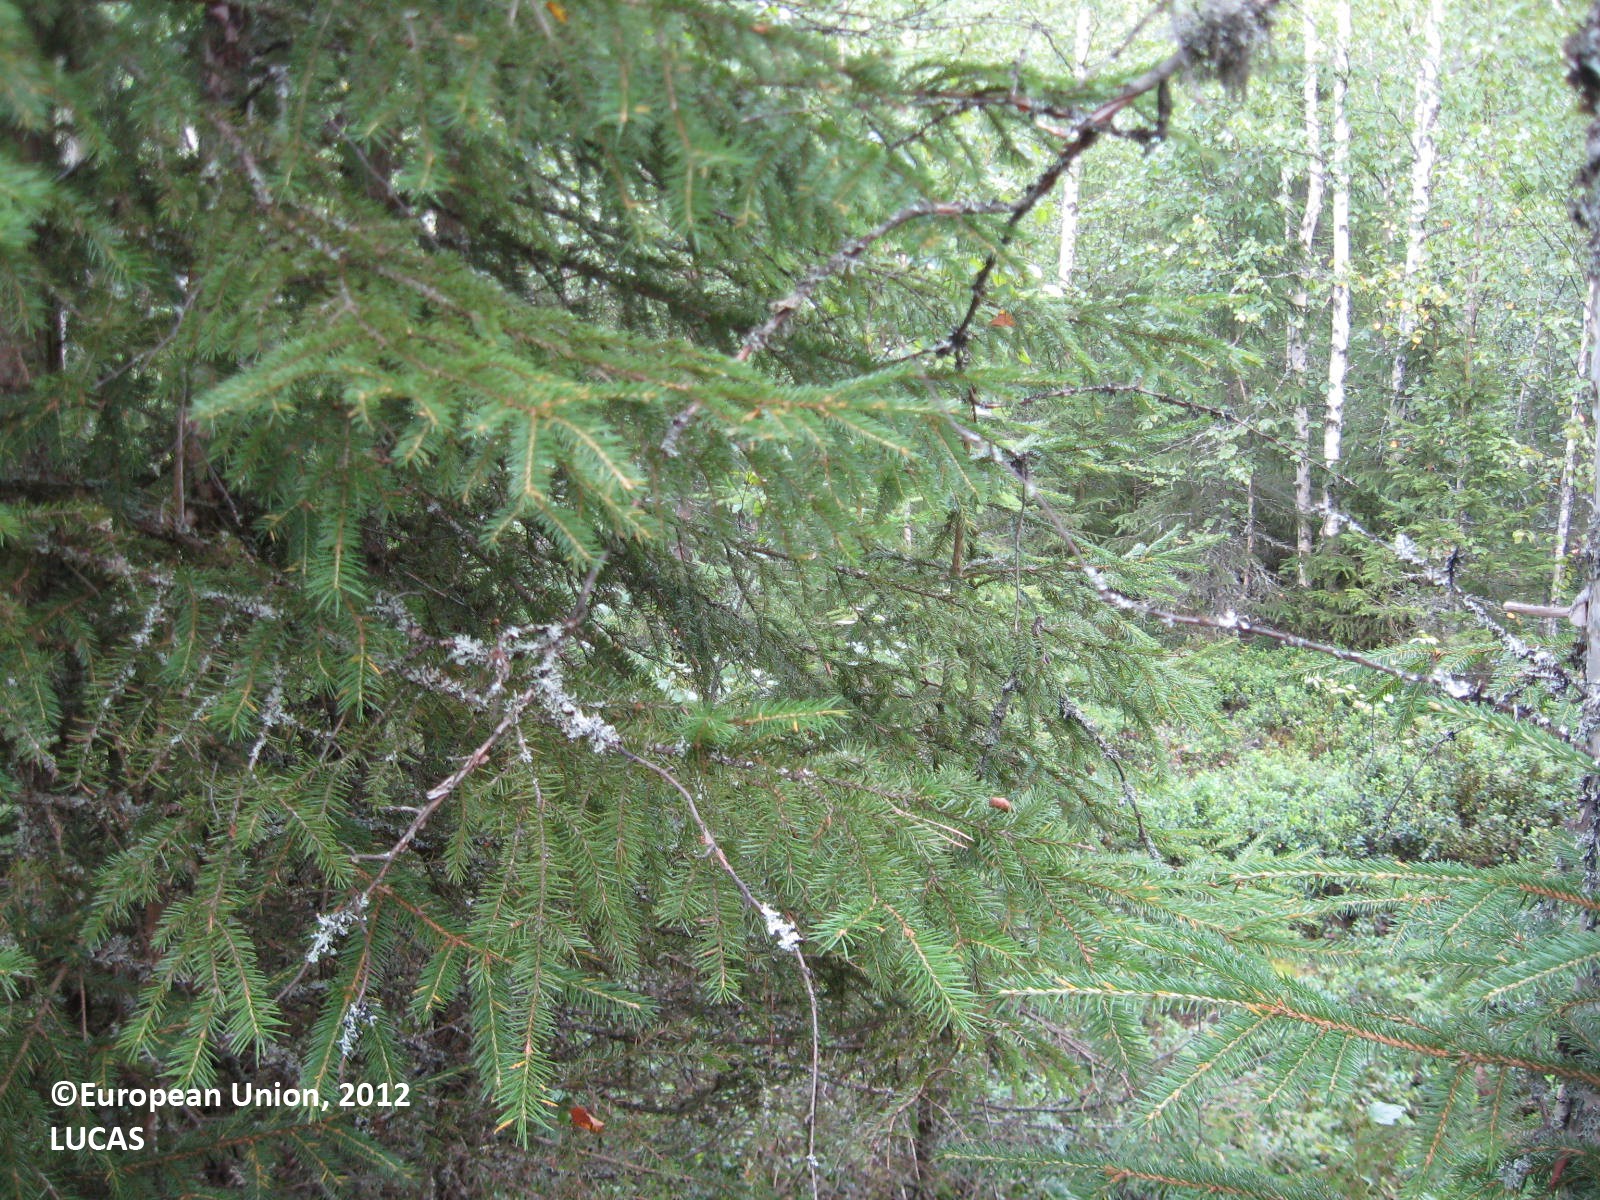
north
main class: Woodland
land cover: Other mixed woodland
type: boreal forest
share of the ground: > 75 %
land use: Forestry
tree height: > 5 m
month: July
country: FI
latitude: 61.8571
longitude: 22.4320
